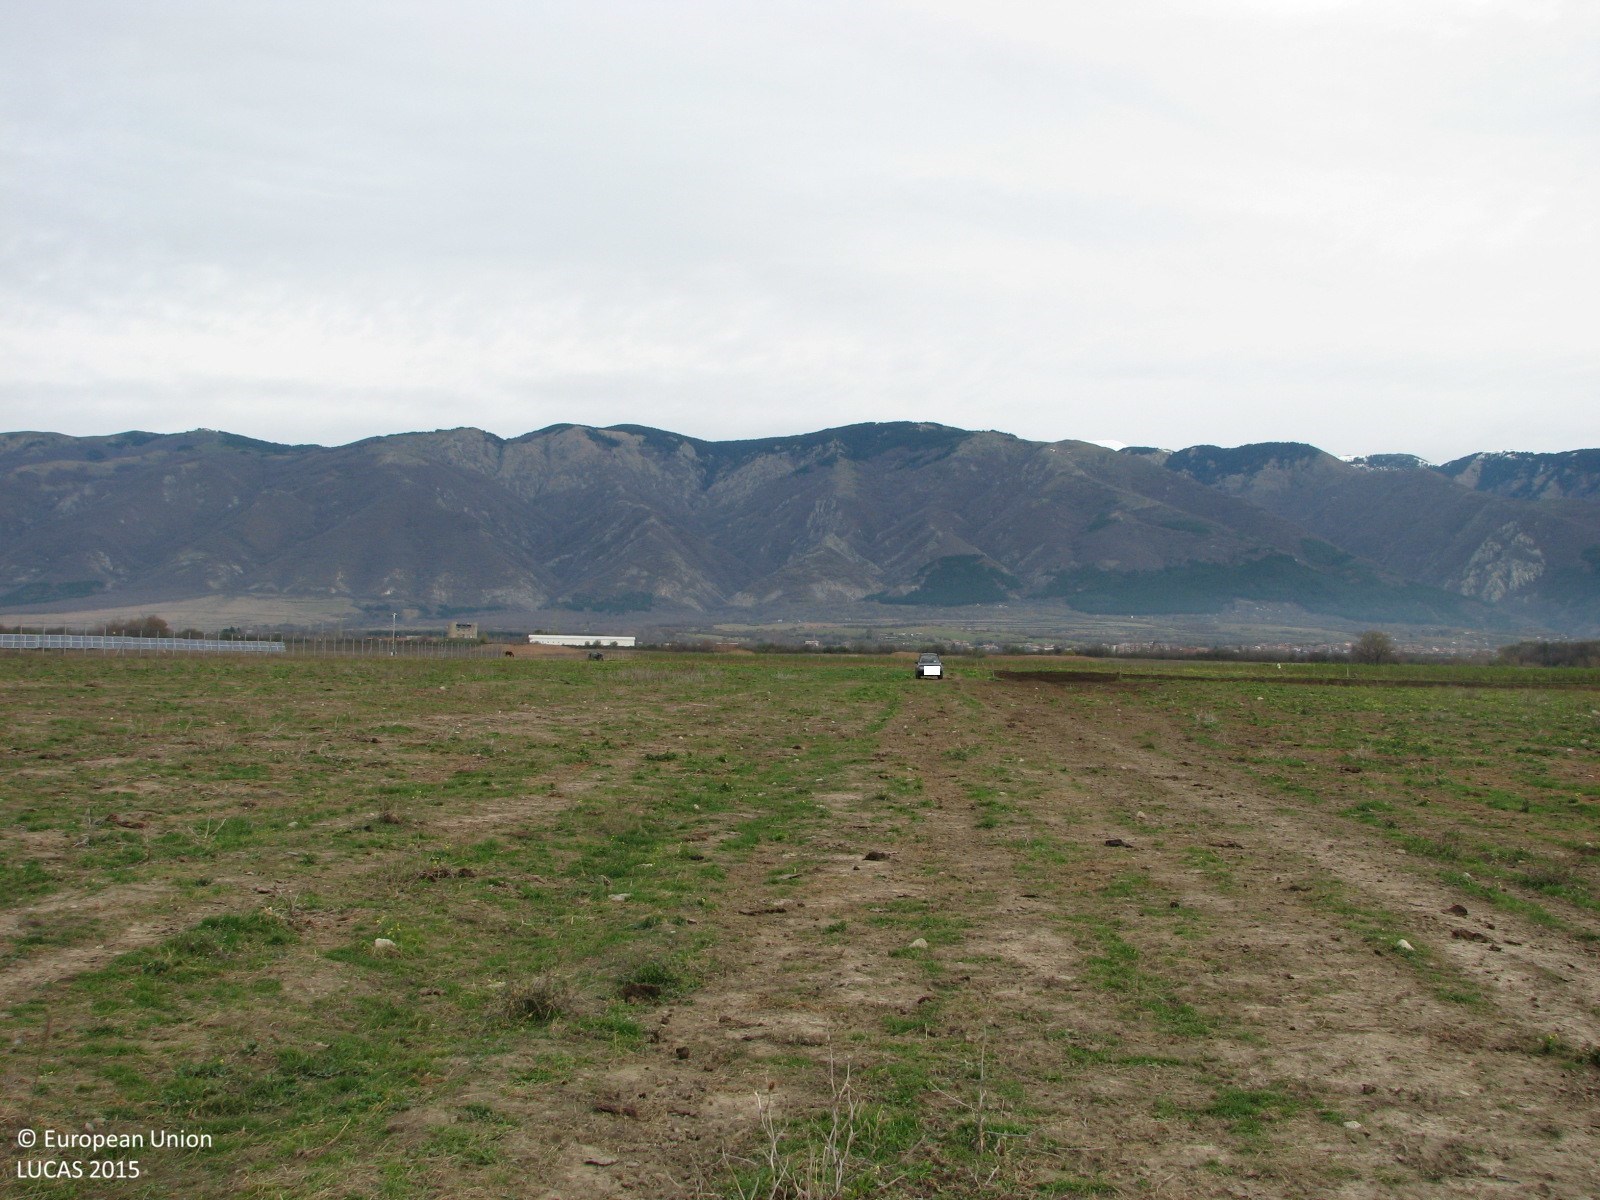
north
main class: Grassland
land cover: Spontaneously vegetated surfaces
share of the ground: 50 - 75 %
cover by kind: herbaceous plants 70 %, unconsolidated bare surface 30 %
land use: Agriculture (excluding fallow land and kitchen gardens)
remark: Harvested field
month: December
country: BG
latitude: 42.6372
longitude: 24.7027
